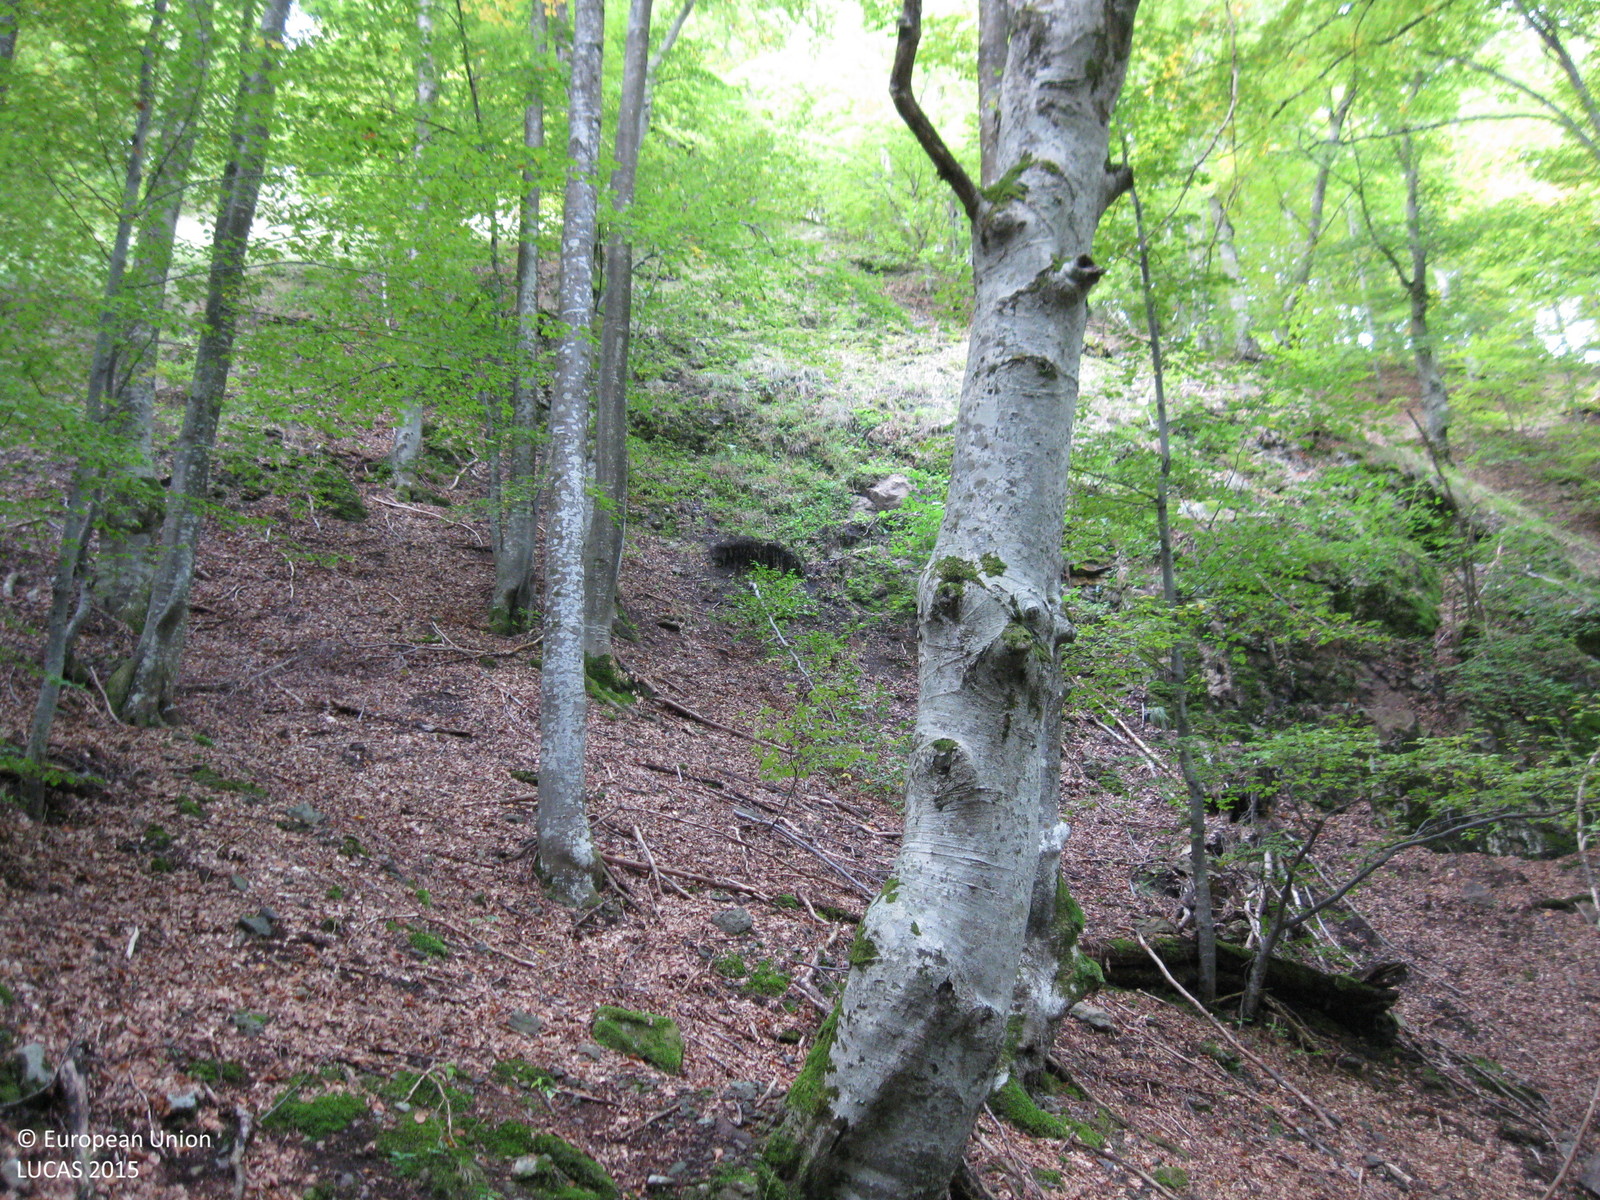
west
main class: Woodland
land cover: Broadleaved woodland
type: beech forest
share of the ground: > 75 %
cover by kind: broadleaved forest trees 100 %
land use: Forestry
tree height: > 5 m
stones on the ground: < 10 %
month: October
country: BG
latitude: 41.7570
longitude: 24.9521
